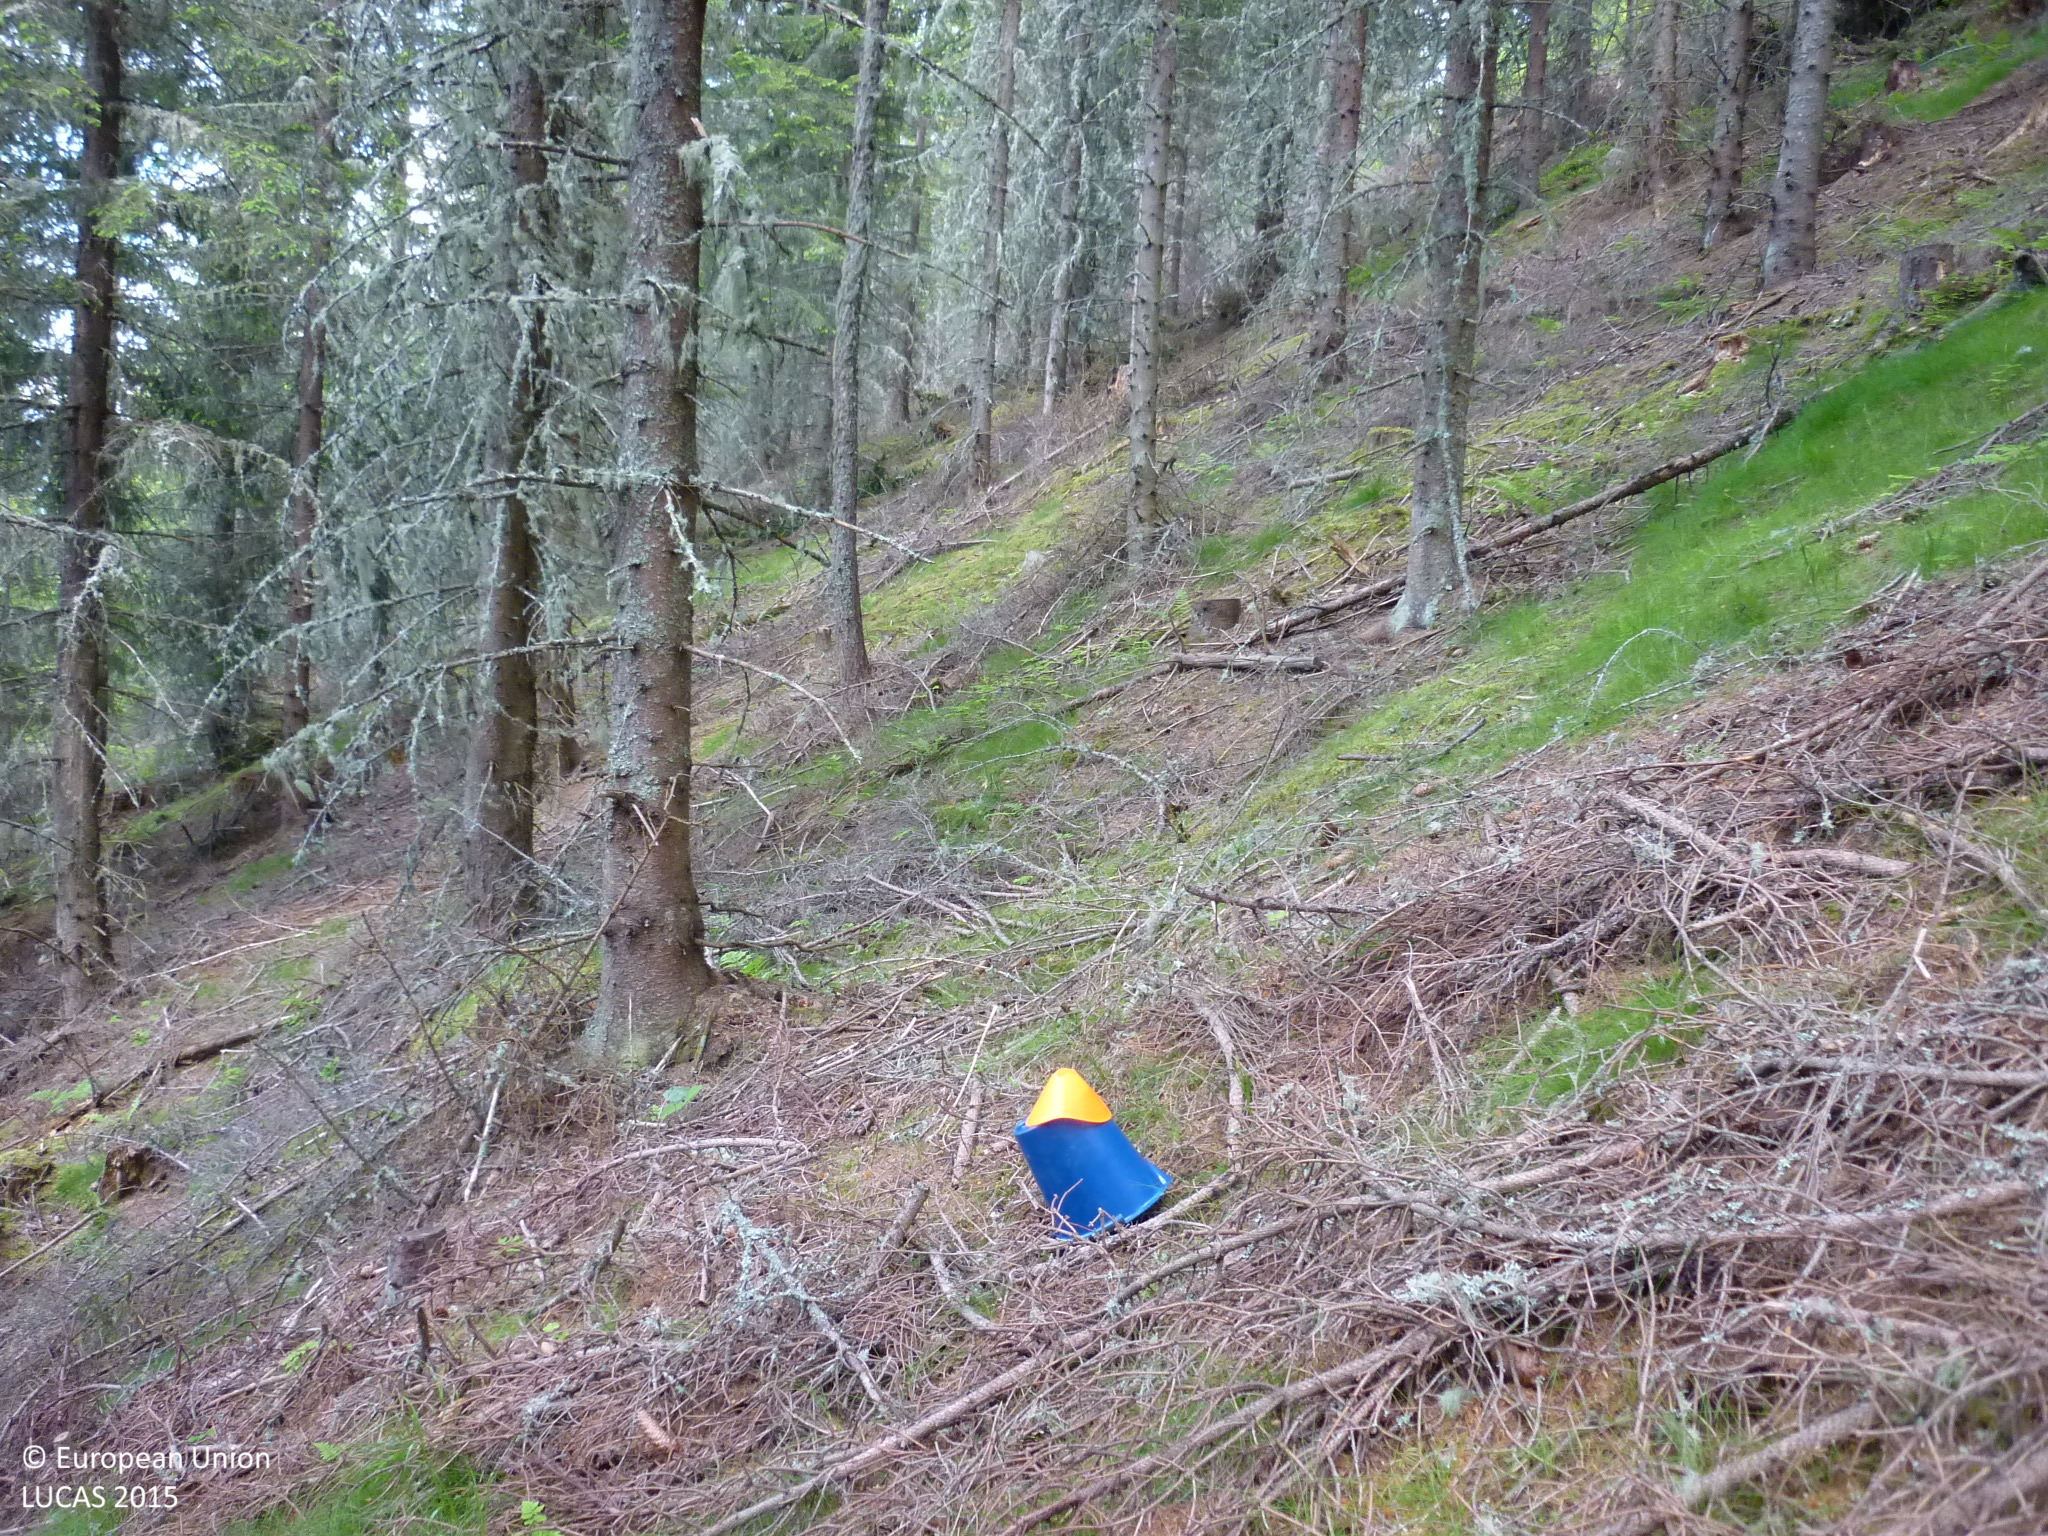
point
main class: Woodland
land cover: Spruce dominated coniferous woodland
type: alpine coniferous forest
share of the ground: > 75 %
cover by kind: coniferous forest trees 80 %, herbaceous plants 10 %, lichens and mosses 5 %, unconsolidated bare surface 5 %
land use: Forestry
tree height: > 5 m
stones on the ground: < 10 %
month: June
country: AT
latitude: 47.1751
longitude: 14.0752
